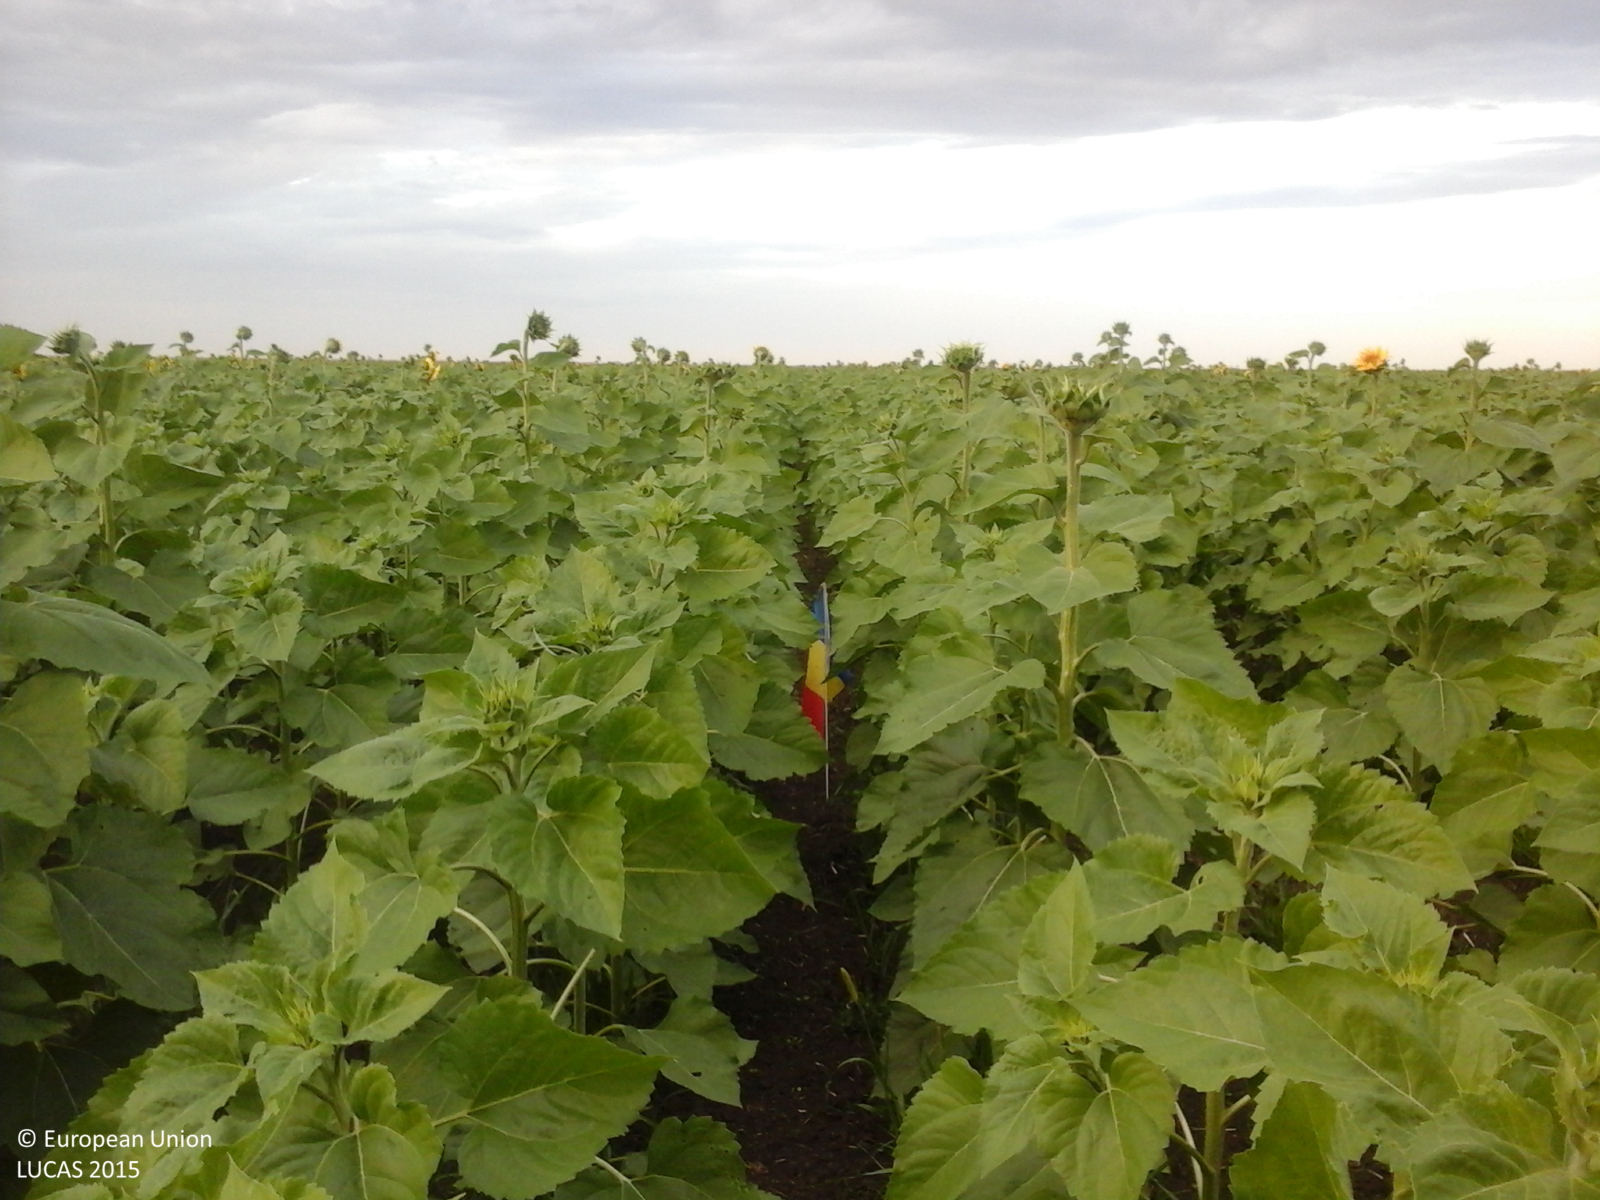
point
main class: Cropland
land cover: Sunflower
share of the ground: > 75 %
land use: Agriculture (excluding fallow land and kitchen gardens)
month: July
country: RO
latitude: 44.1413
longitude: 24.8120
